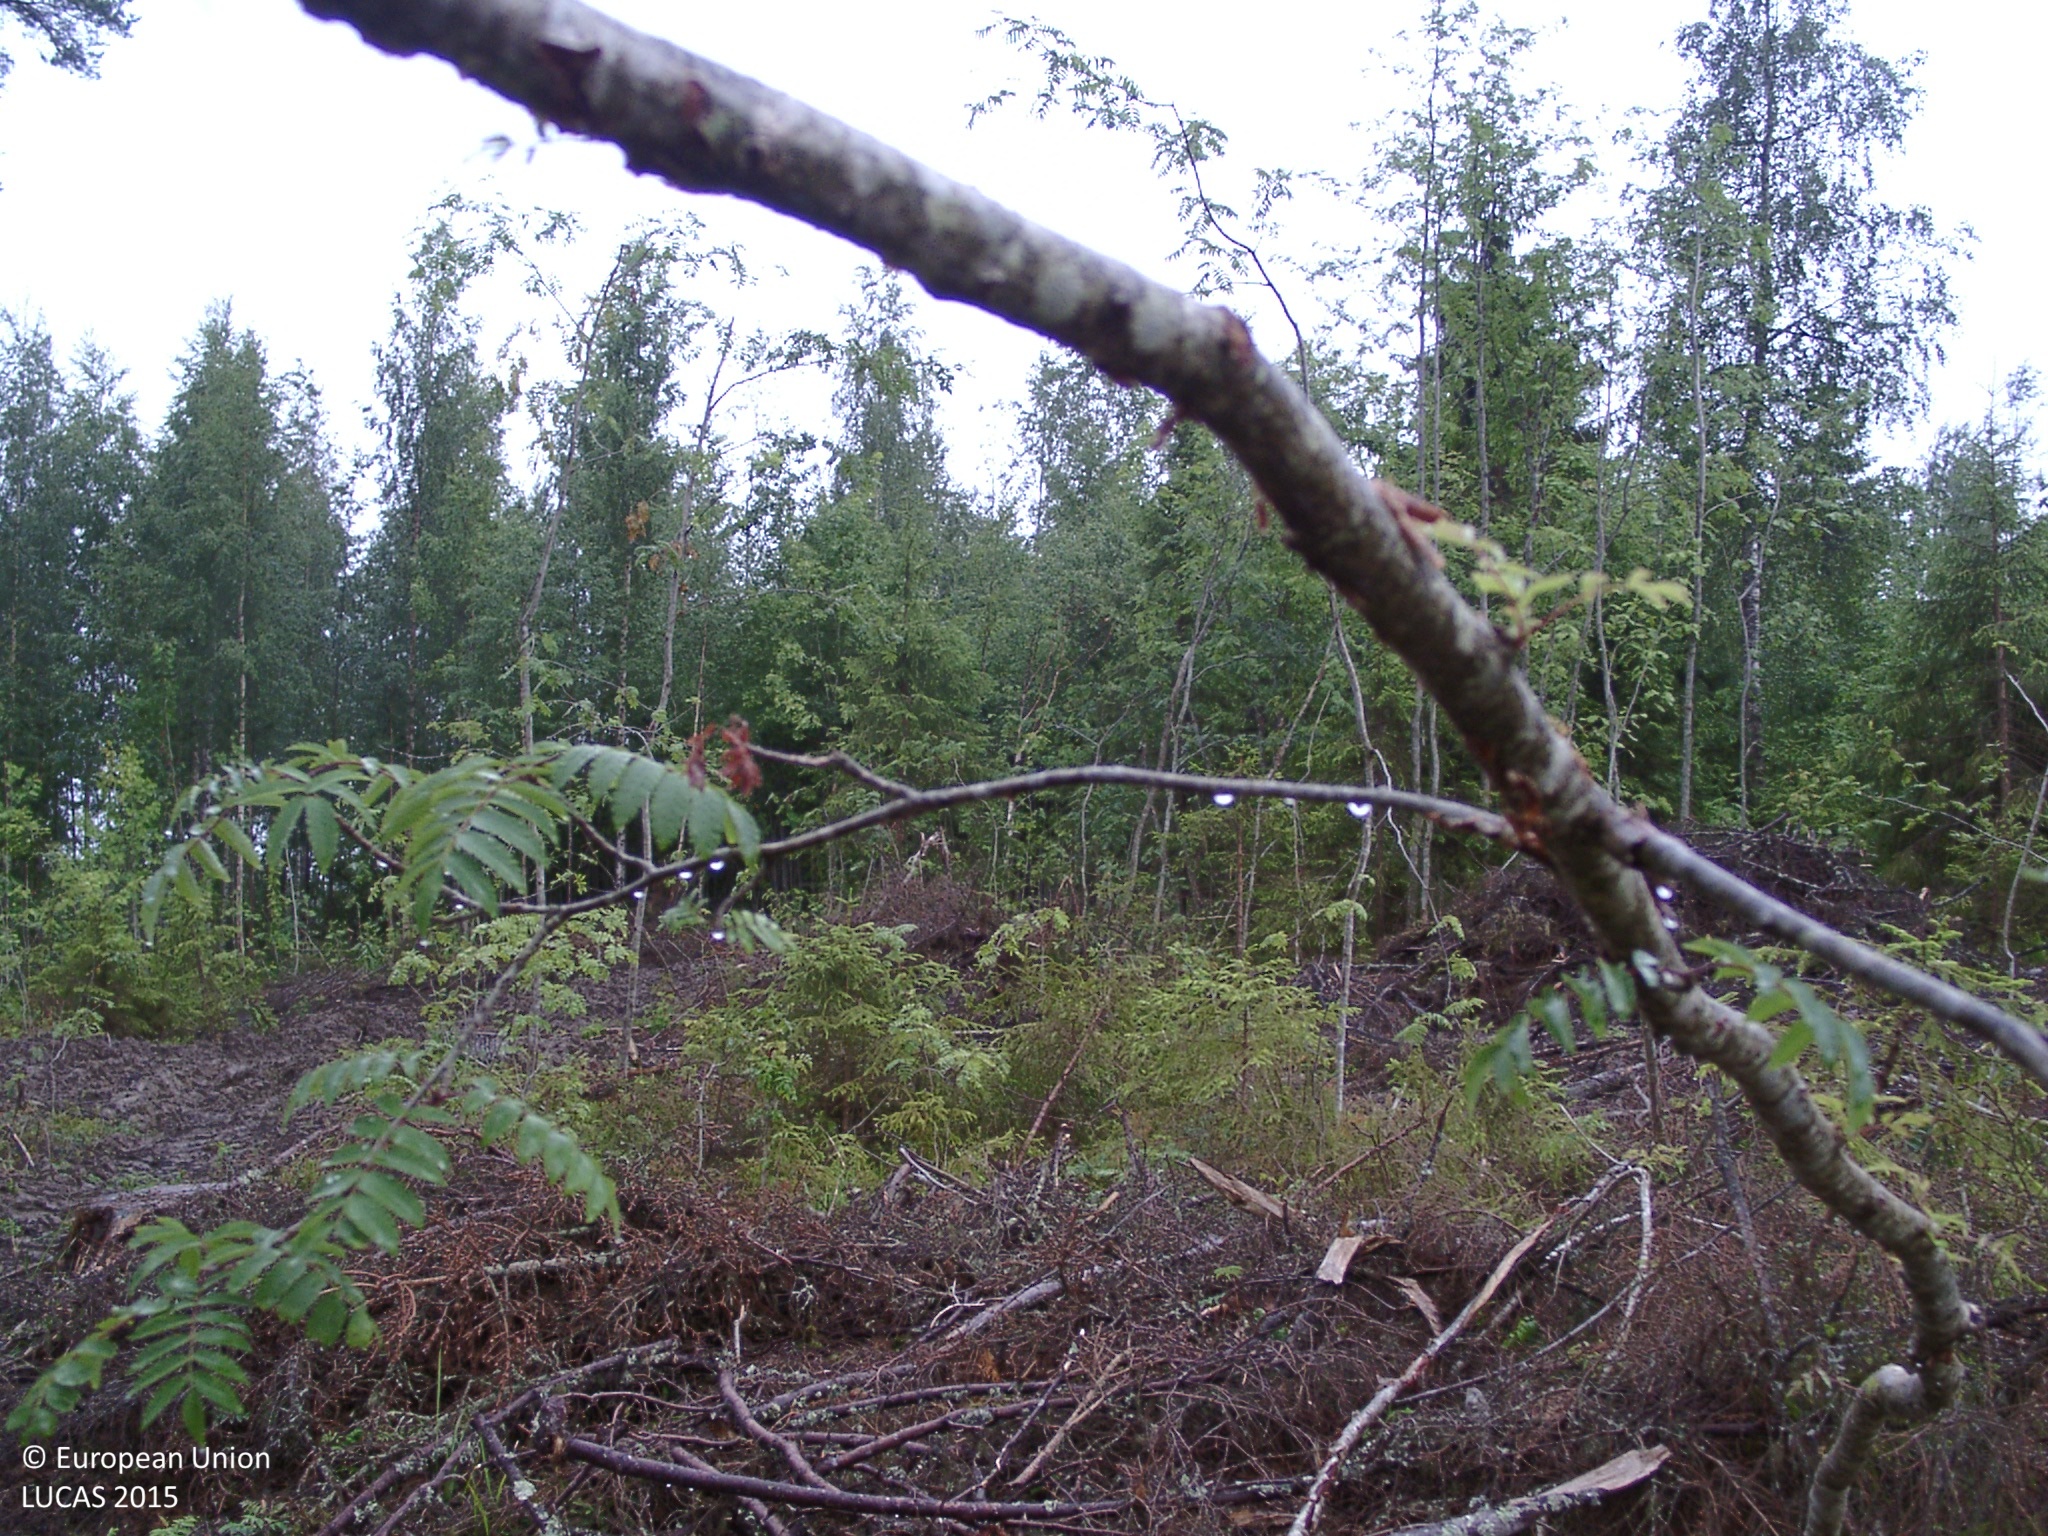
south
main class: Shrubland
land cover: Shrubland with sparse tree cover
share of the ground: 10 - 25 %
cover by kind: unconsolidated bare surface 40 %, shrubs 10 %, broadleaved forest trees 5 %, herbaceous plants 5 %
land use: Forestry
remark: Clear cut
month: July
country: FI
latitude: 62.3060
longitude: 25.4459
